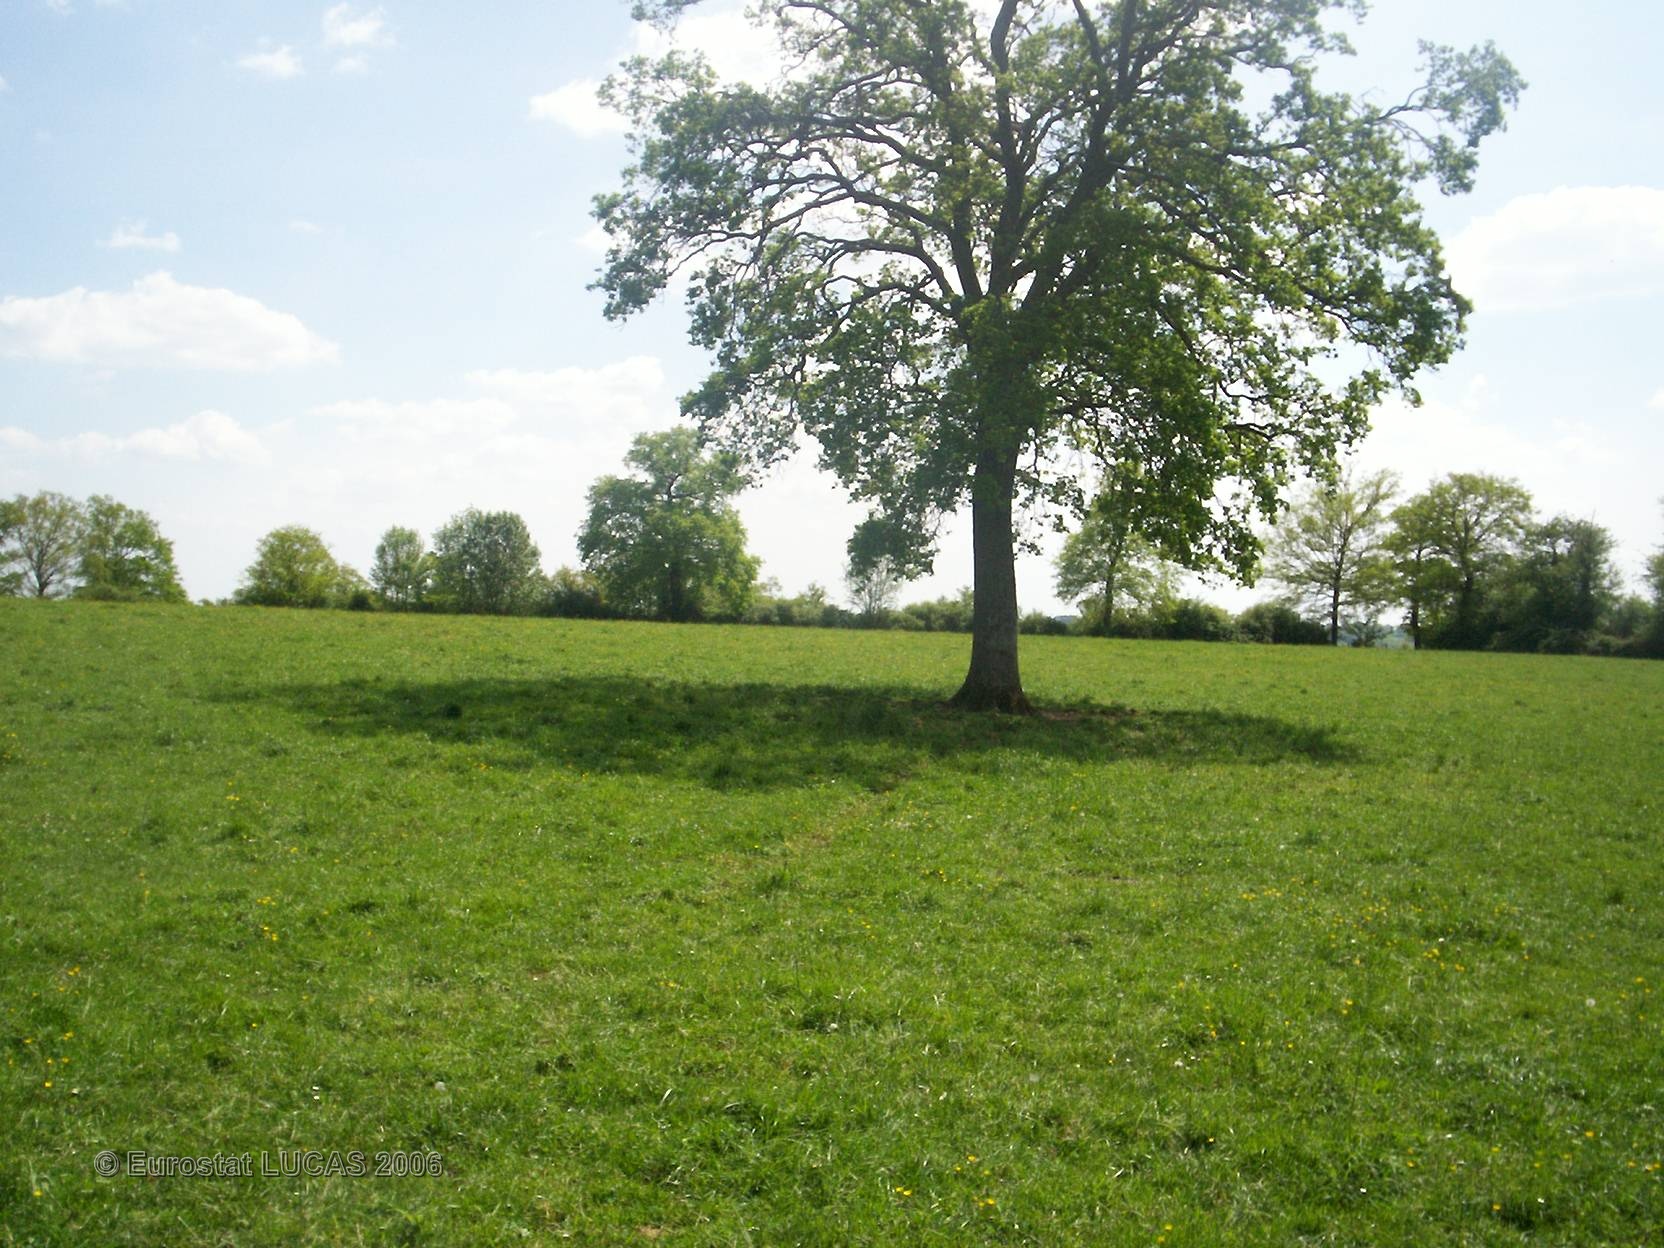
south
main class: Grassland
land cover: Grassland without tree/shrub cover
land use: Agriculture (excluding fallow land and kitchen gardens)
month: May
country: FR
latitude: 45.9664
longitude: 0.7340
